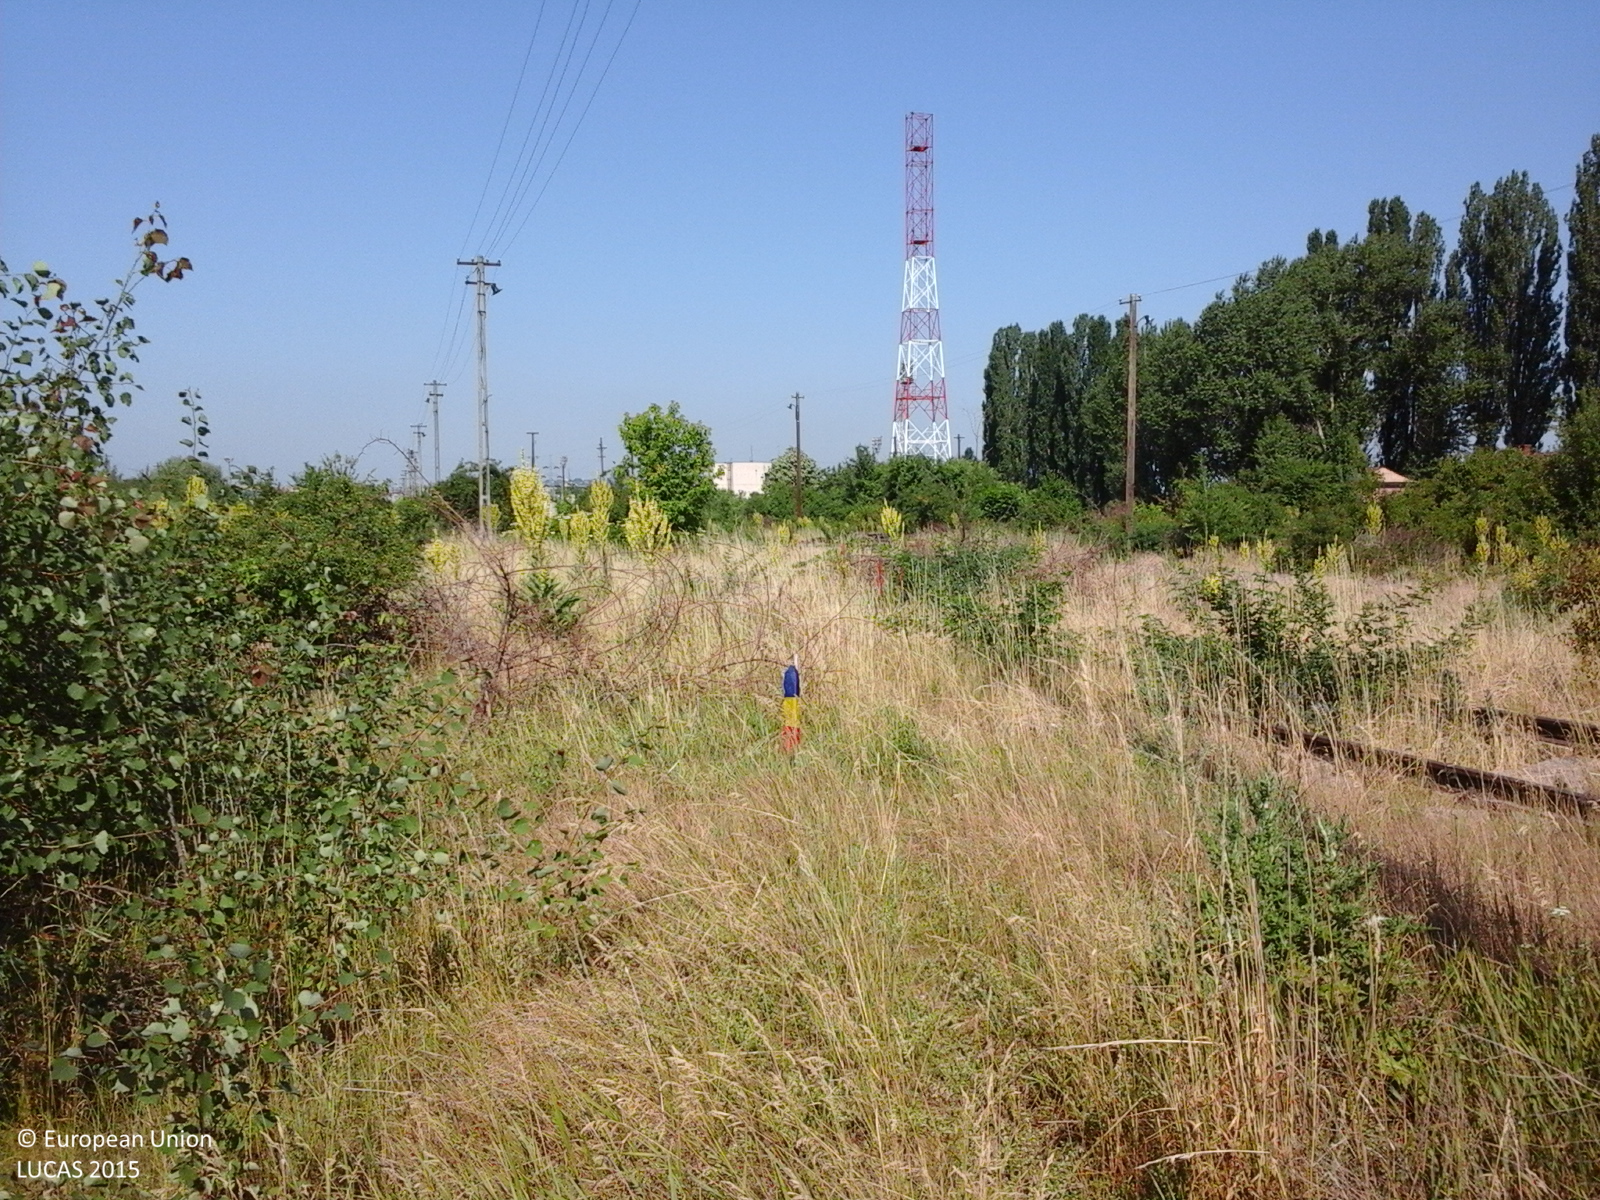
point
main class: Grassland
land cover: Grassland with sparse tree/shrub cover
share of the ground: 25 - 50 %
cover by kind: herbaceous plants 90 %, broadleaved forest trees 5 %, shrubs 5 %
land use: Railway transport
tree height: < 5 m
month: June
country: RO
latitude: 47.1396
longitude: 27.6164
